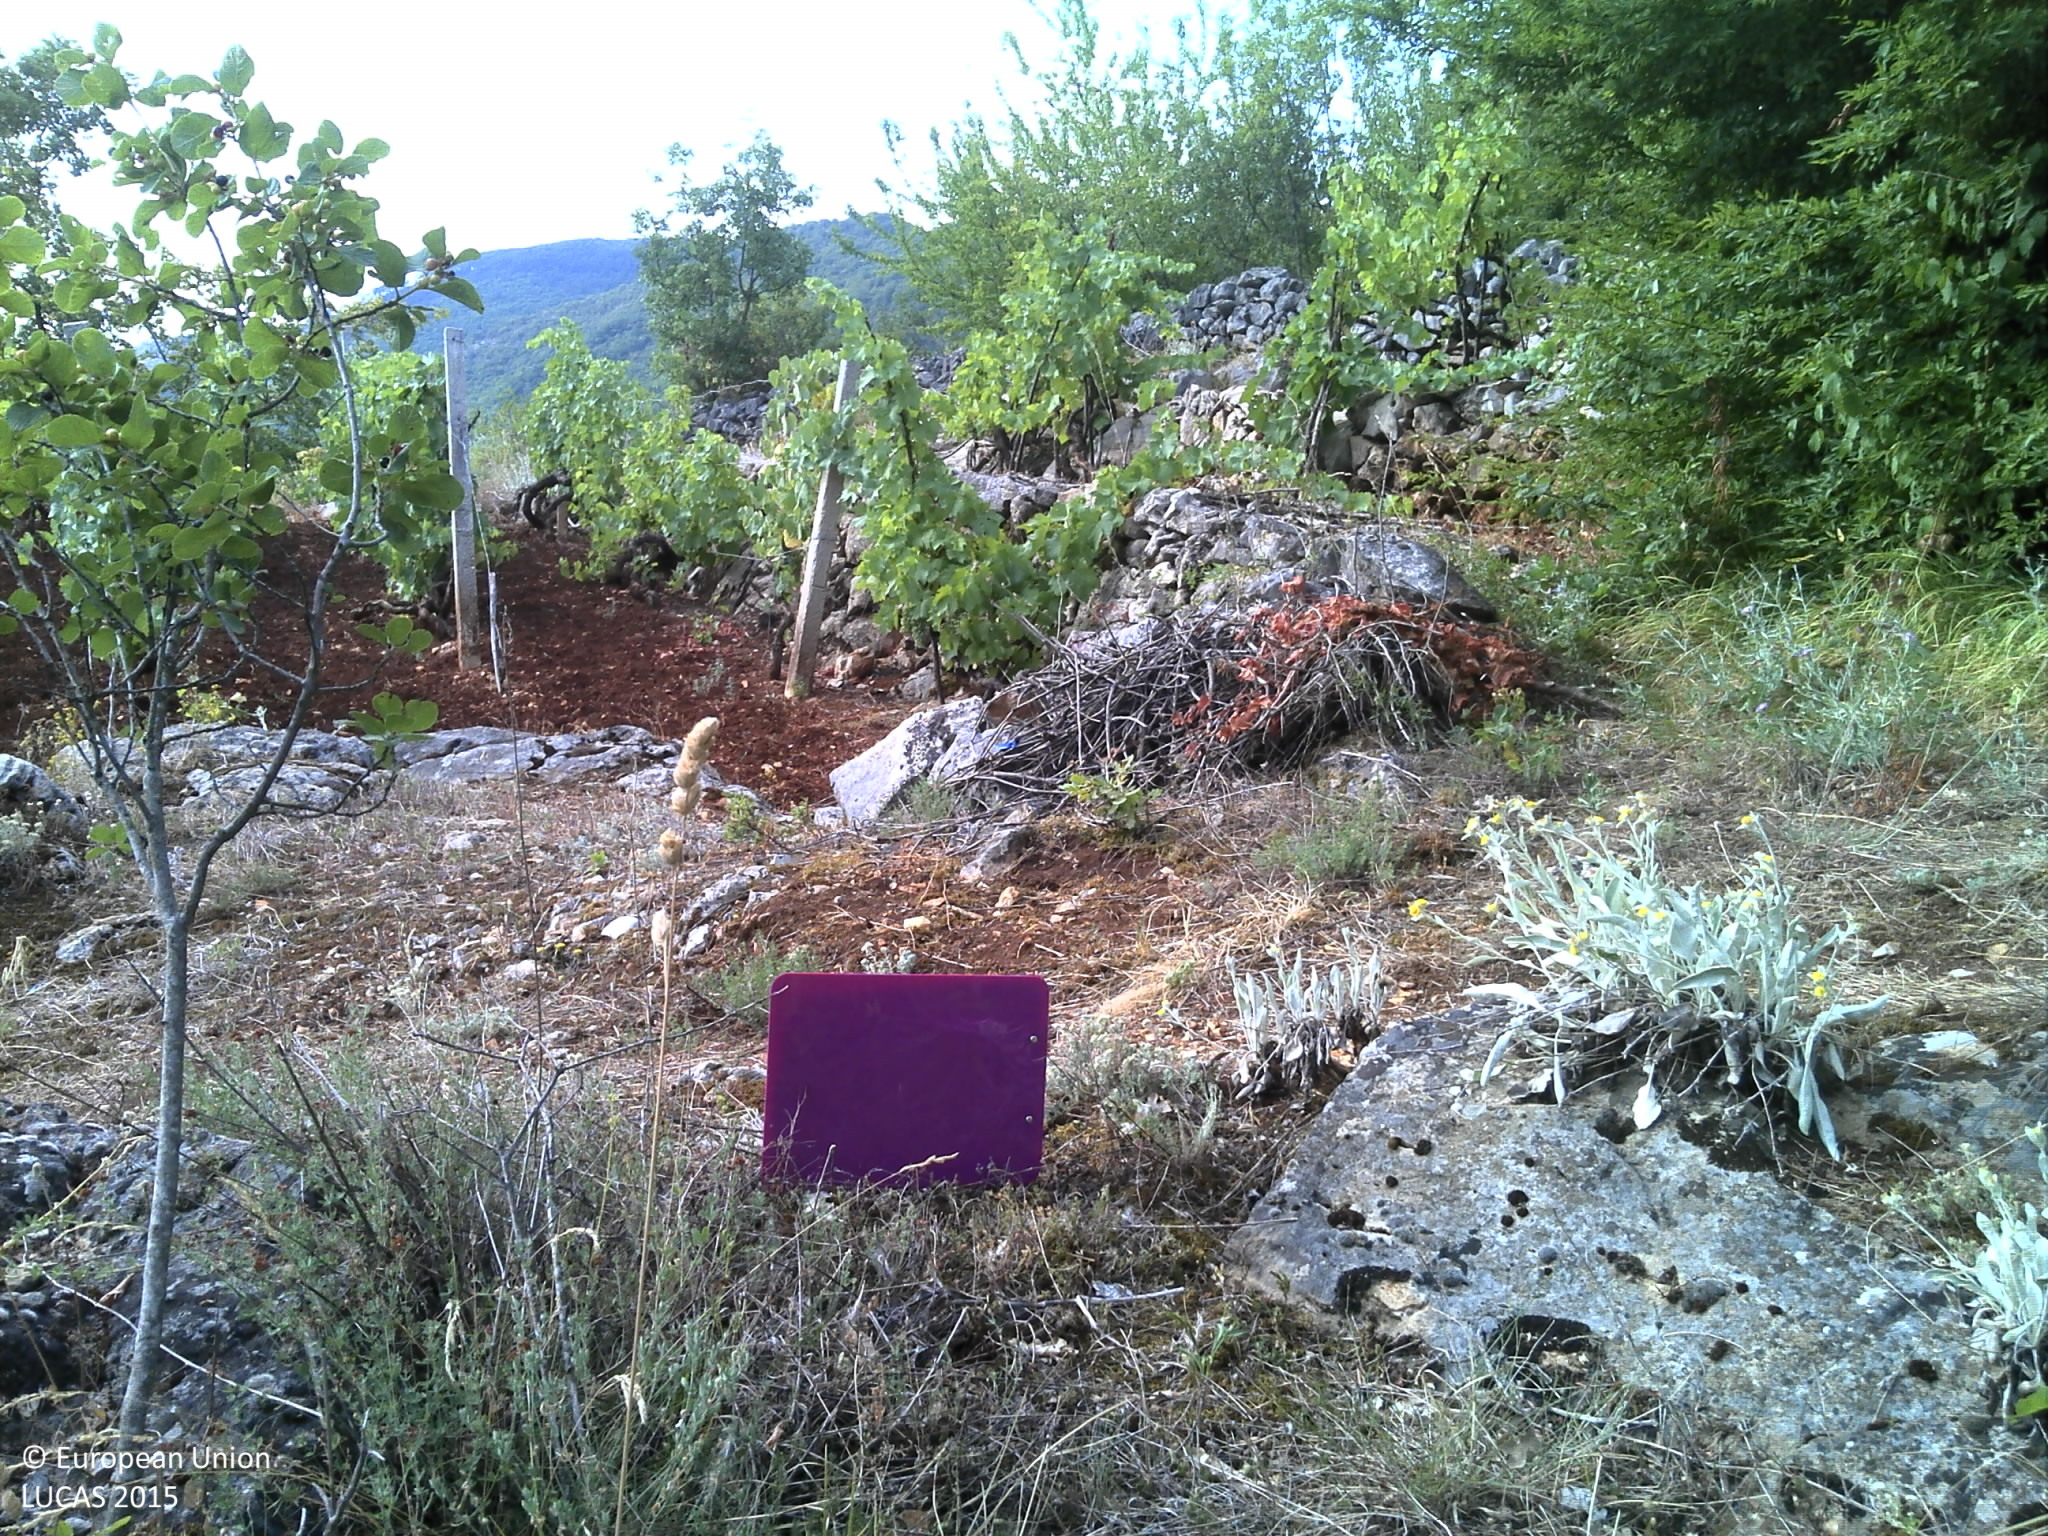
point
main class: Shrubland
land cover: Shrubland with sparse tree cover
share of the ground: > 75 %
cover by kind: shrubs 65 %, herbaceous plants 20 %, broadleaved forest trees 5 %, lichens and mosses 5 %, consolidated bare surface 5 %
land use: Semi-natural and natural areas not in use
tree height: < 5 m
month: July
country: HR
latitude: 43.4556
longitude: 17.0978
